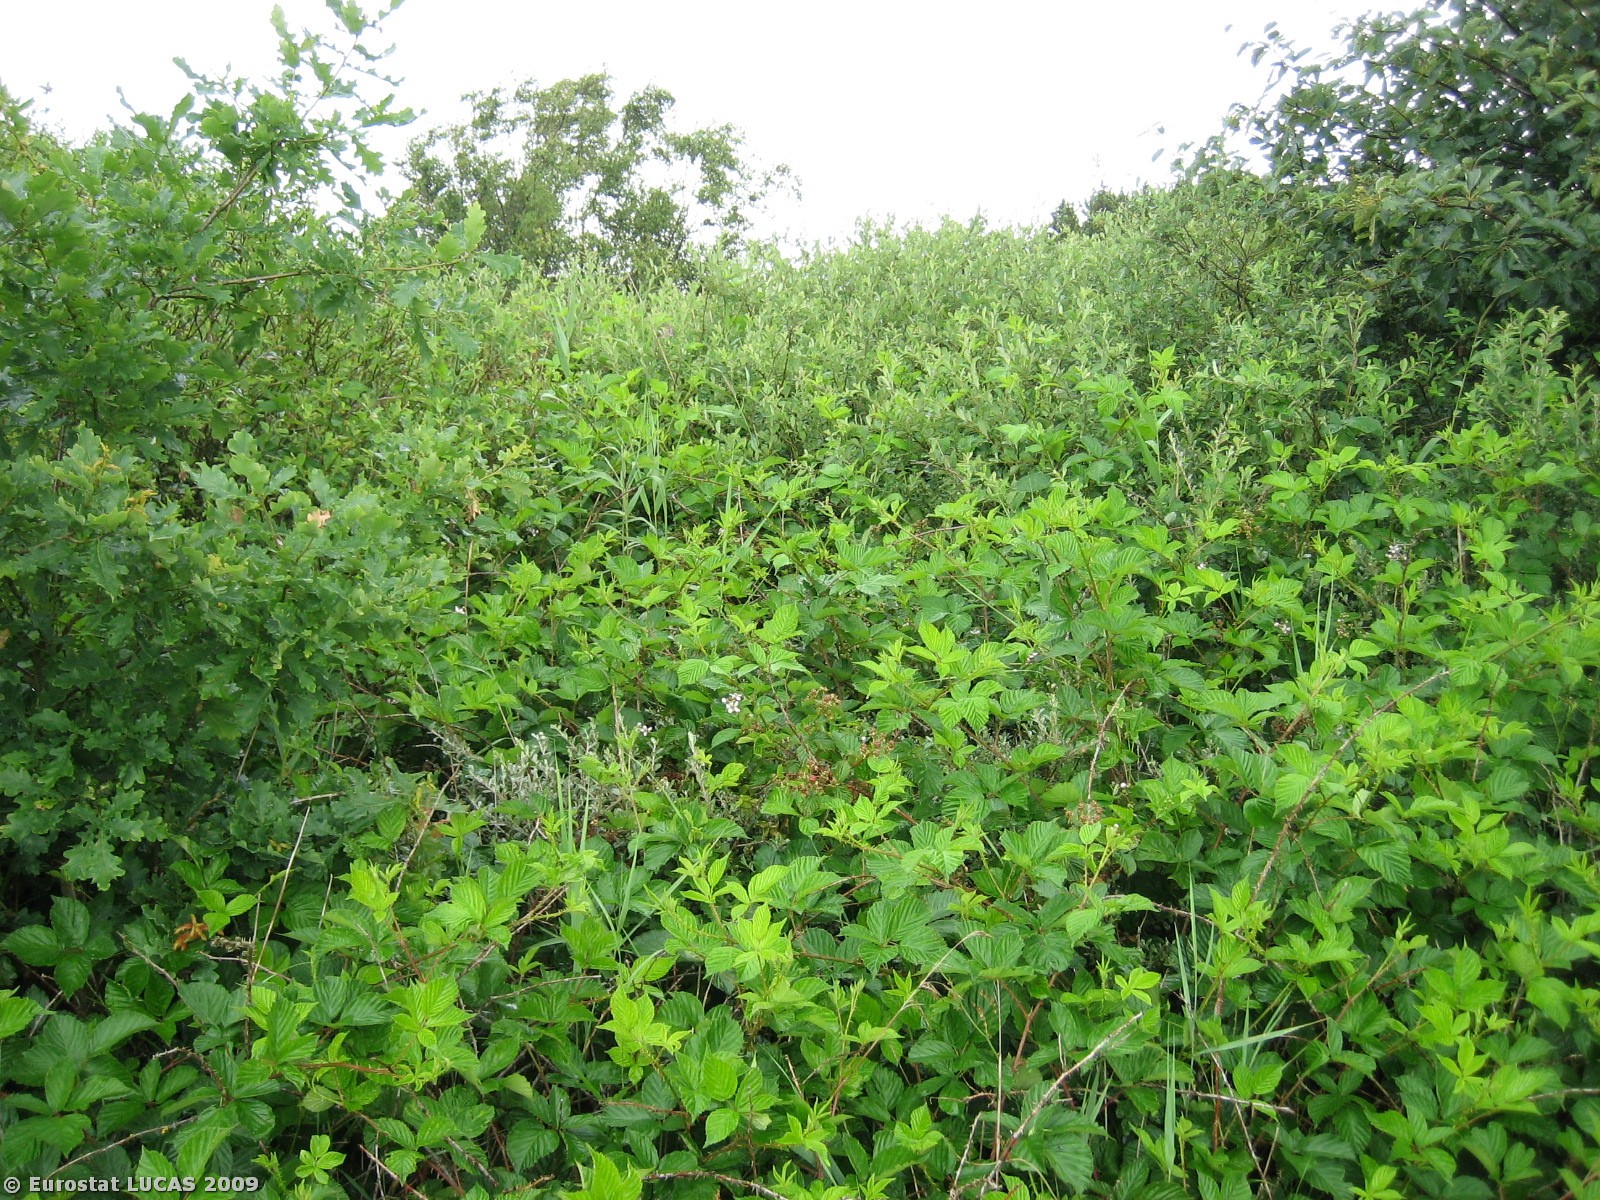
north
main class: Shrubland
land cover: Shrubland with sparse tree cover
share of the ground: > 75 %
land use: Unused
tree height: > 5 m
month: July
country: DK
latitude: 55.6906
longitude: 8.2676
